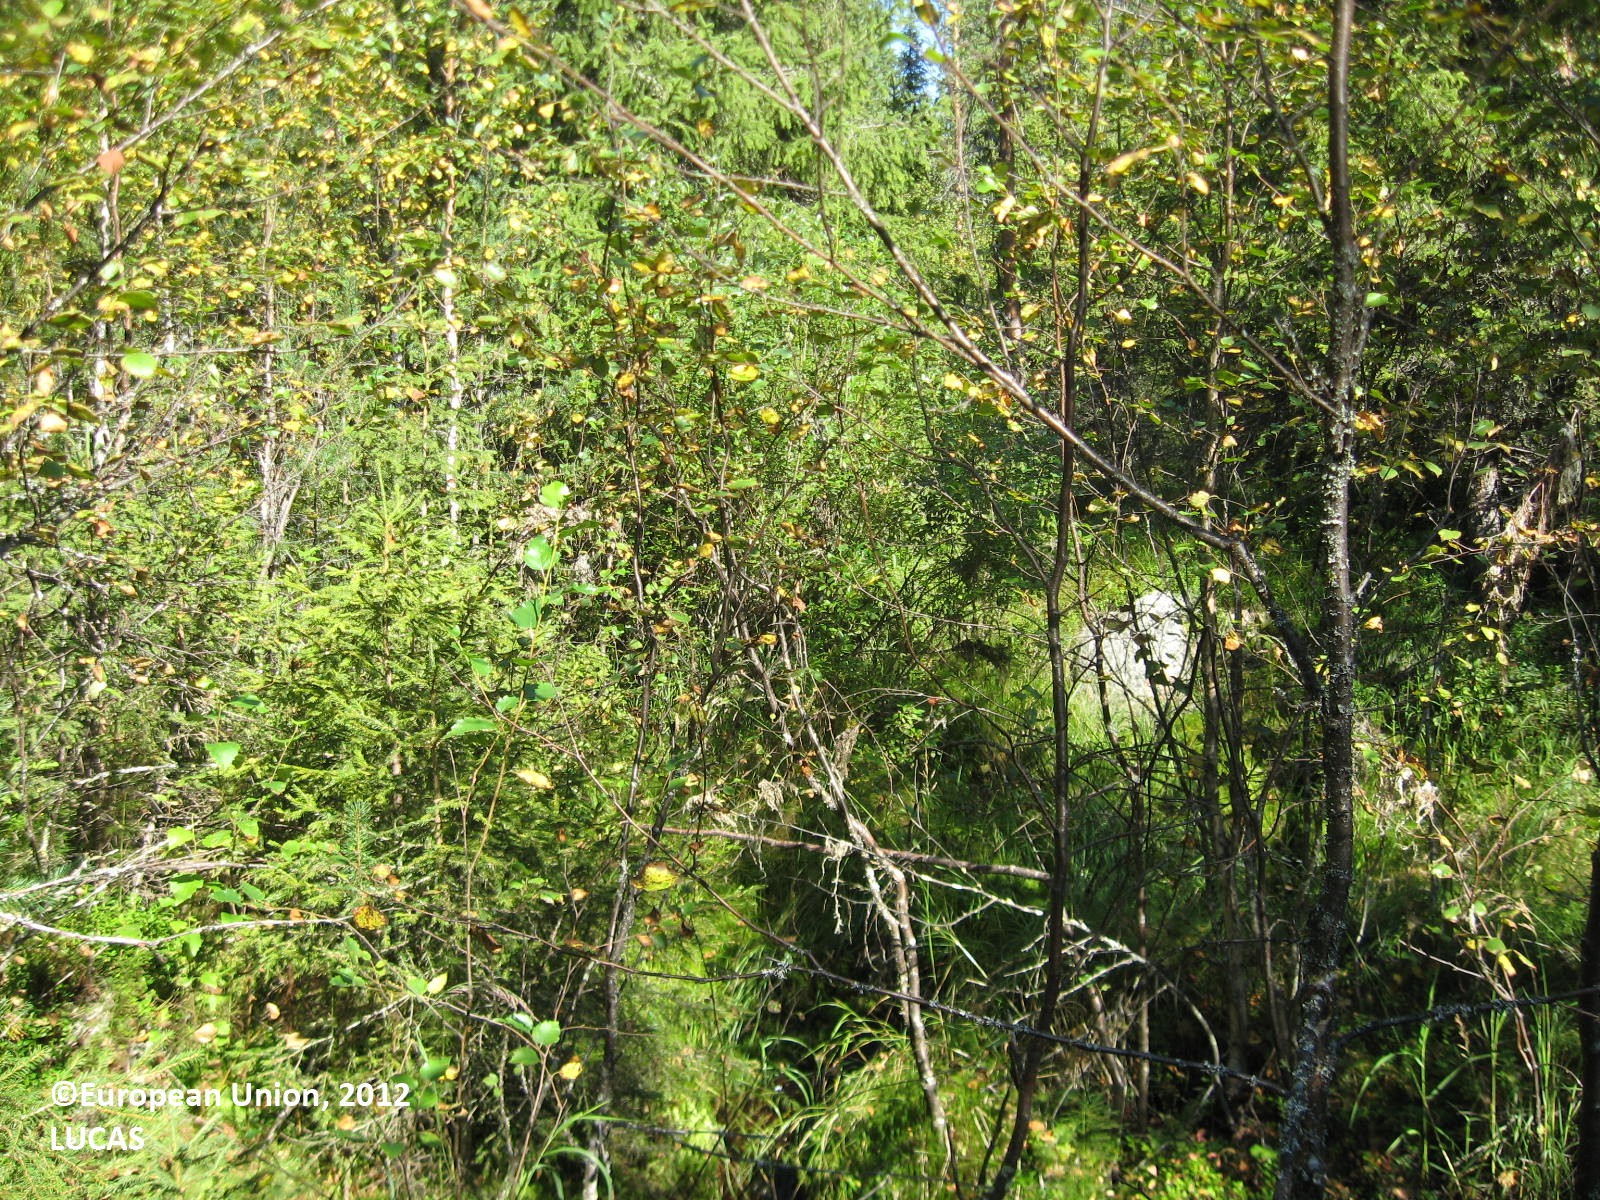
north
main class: Woodland
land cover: Other mixed woodland
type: boreal forest
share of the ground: > 75 %
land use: Forestry
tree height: > 5 m
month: August
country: FI
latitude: 63.8560
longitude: 28.6392
